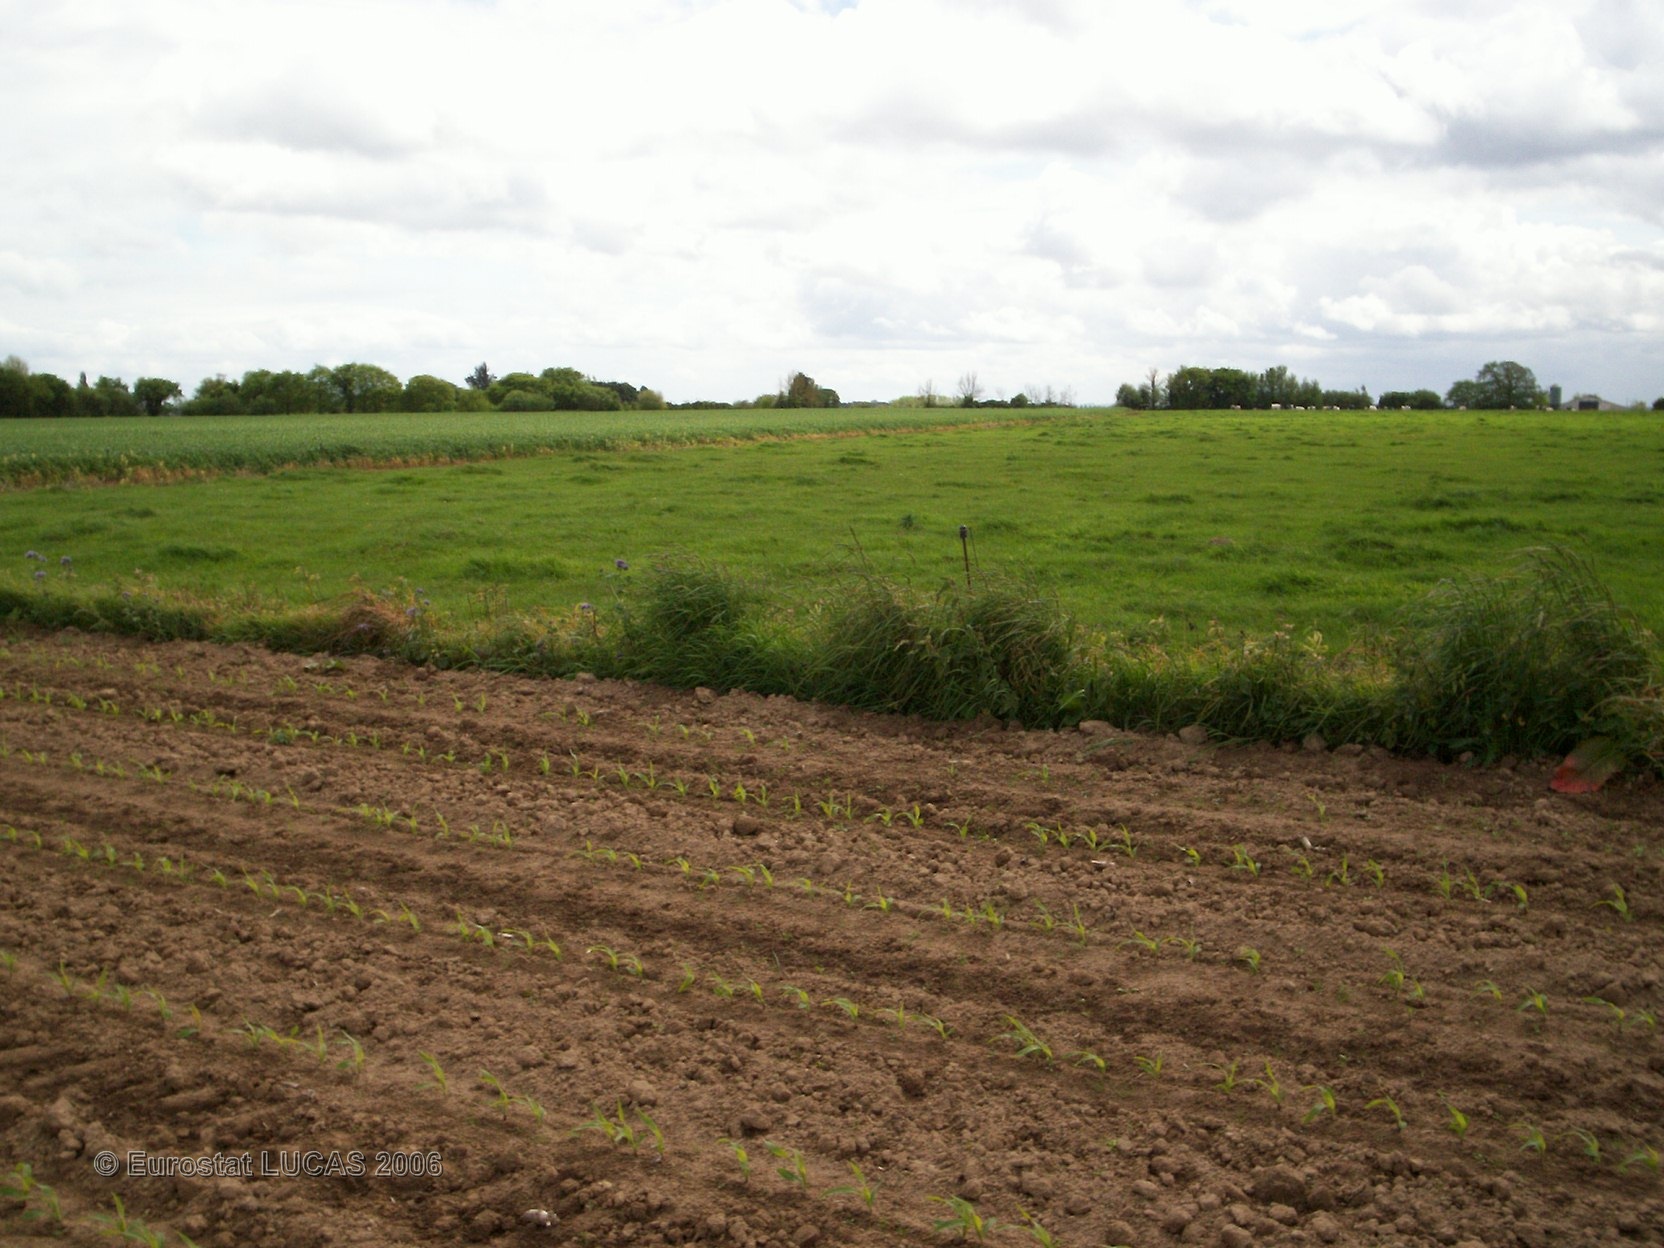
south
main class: Cropland
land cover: Maize
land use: Agriculture (excluding fallow land and kitchen gardens)
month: May
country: FR
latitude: 48.6757
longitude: -2.9580
